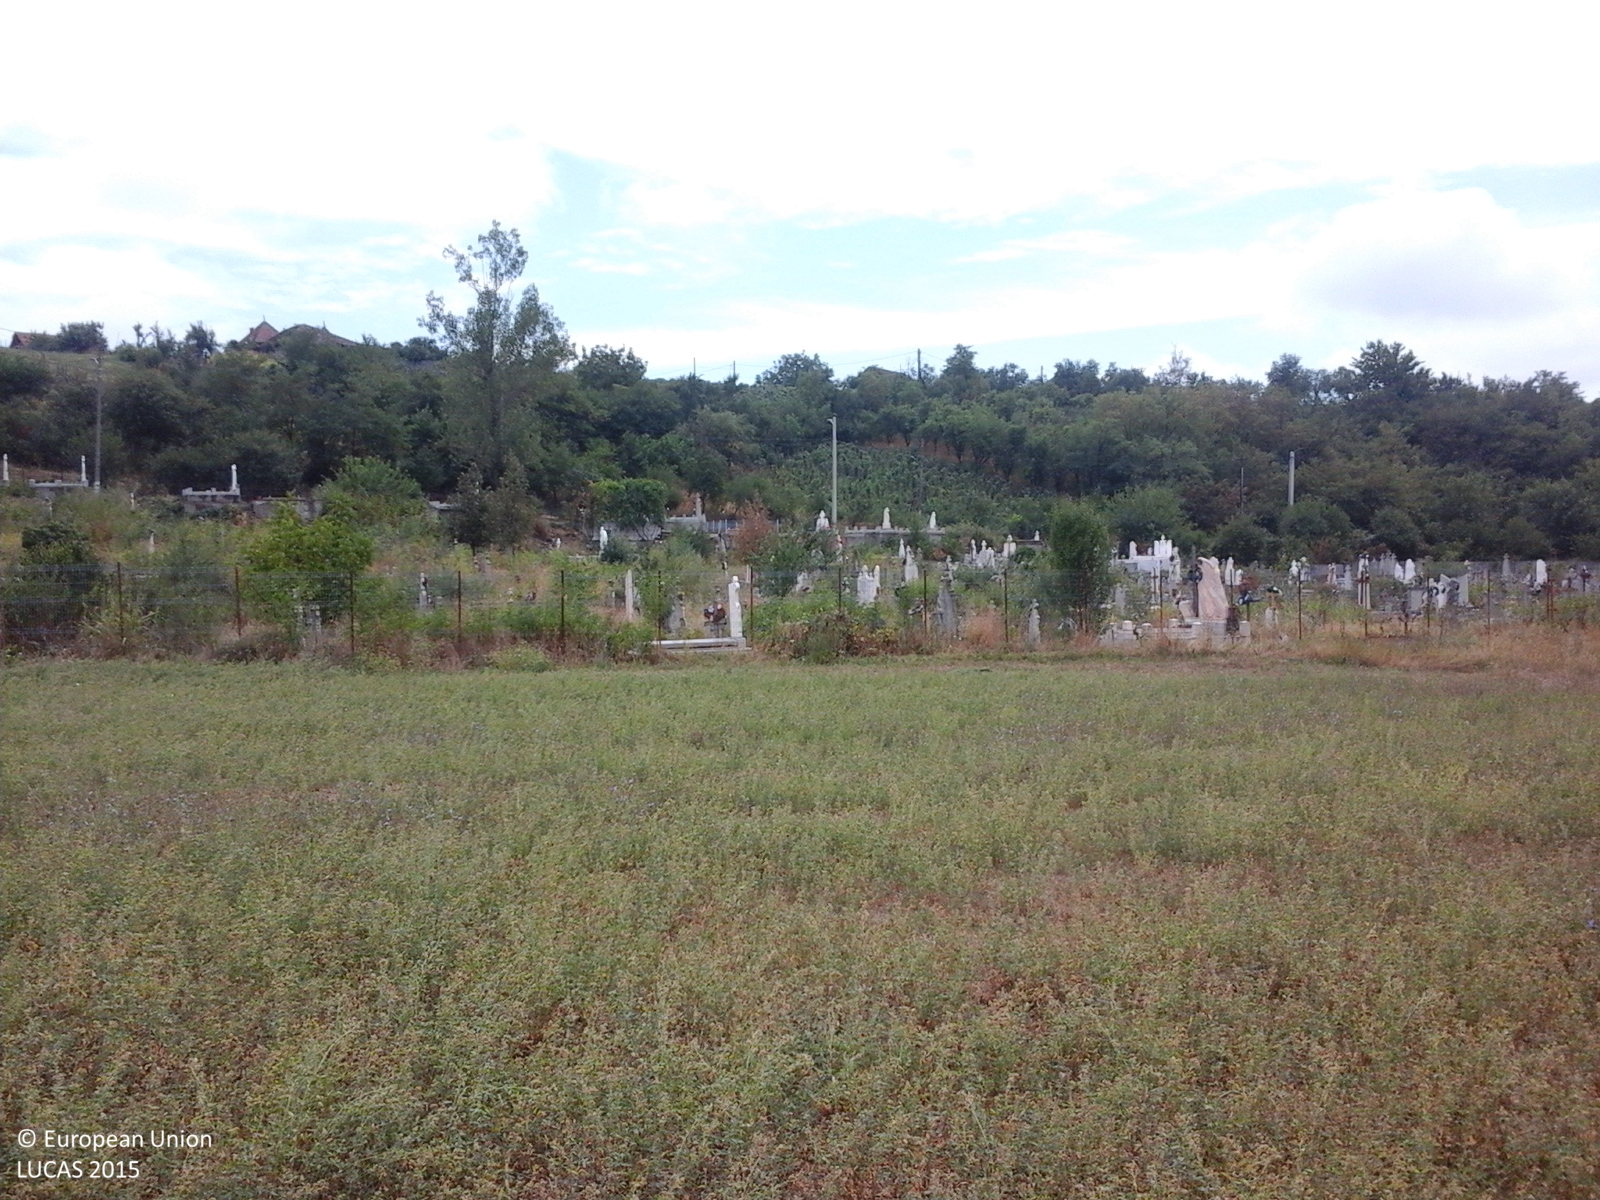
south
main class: Cropland
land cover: Lucerne
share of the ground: > 75 %
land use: Agriculture (excluding fallow land and kitchen gardens)
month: August
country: RO
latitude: 44.6412
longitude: 22.7128
